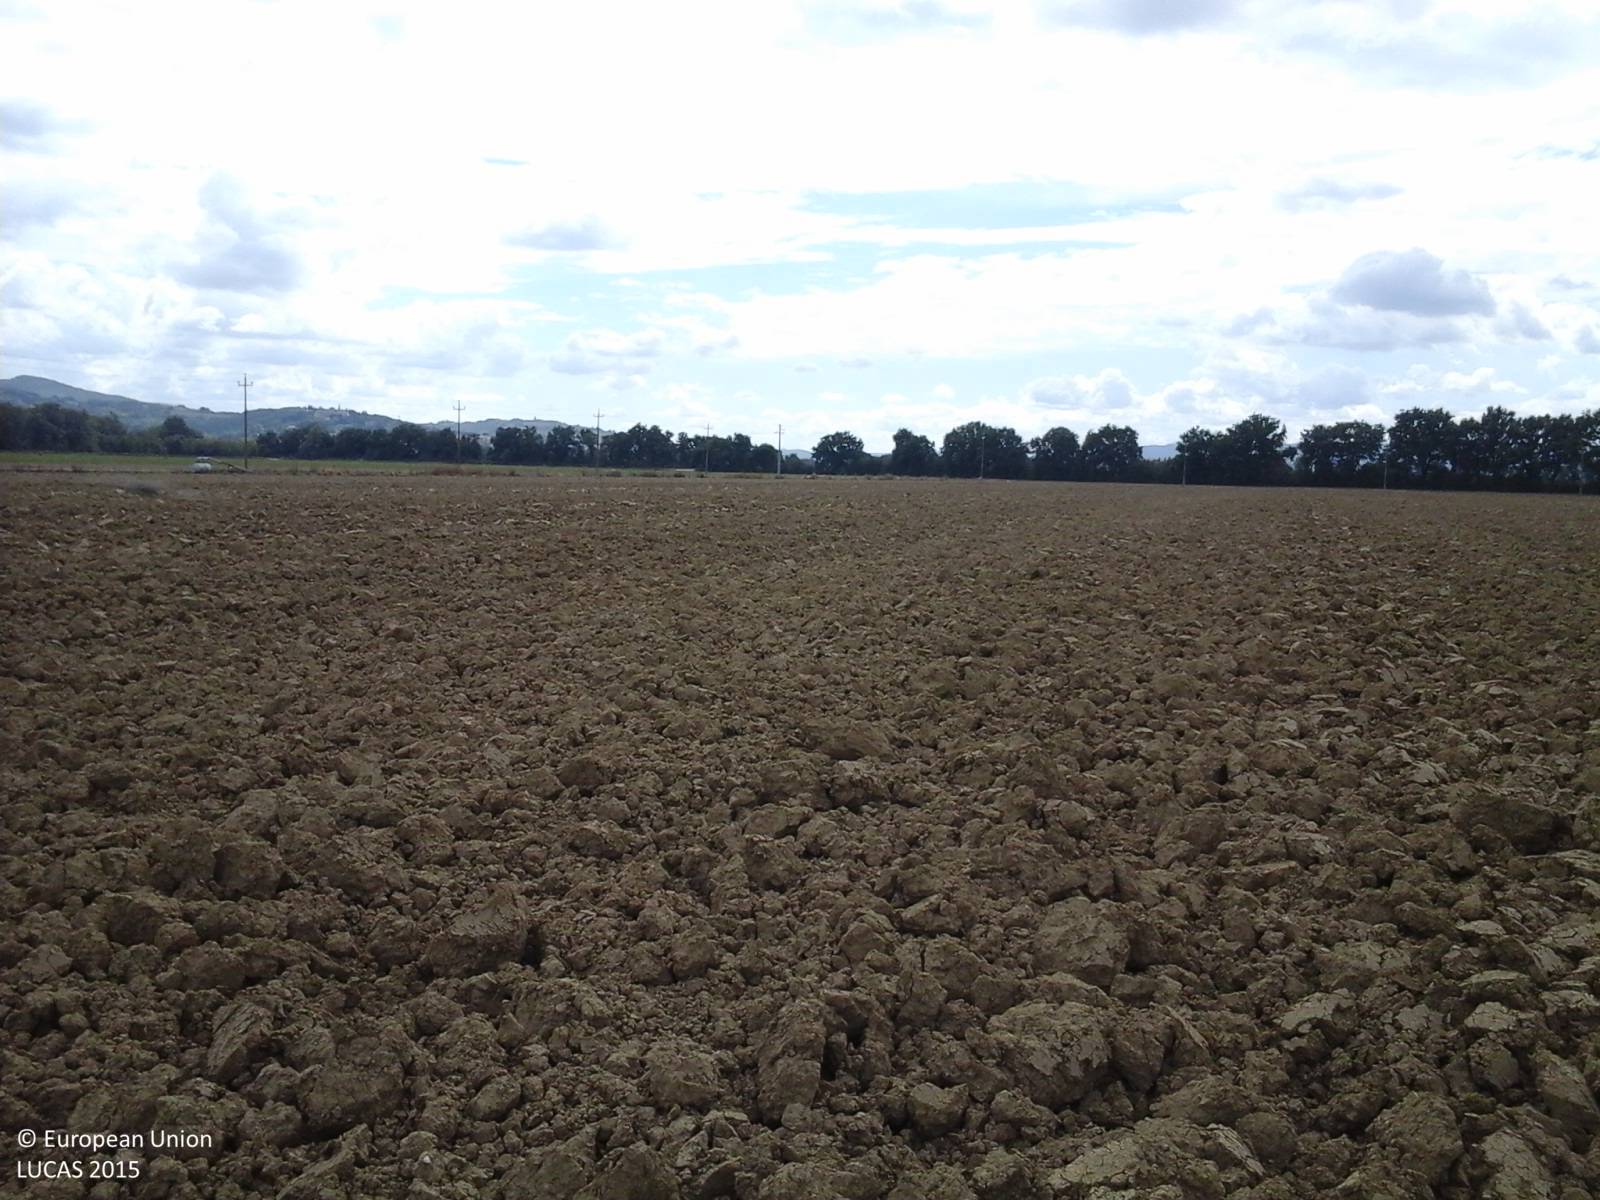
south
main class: Cropland
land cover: Other fresh vegetables
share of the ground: < 10 %
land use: Agriculture (excluding fallow land and kitchen gardens)
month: September
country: IT
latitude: 42.9512
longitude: 12.3830
